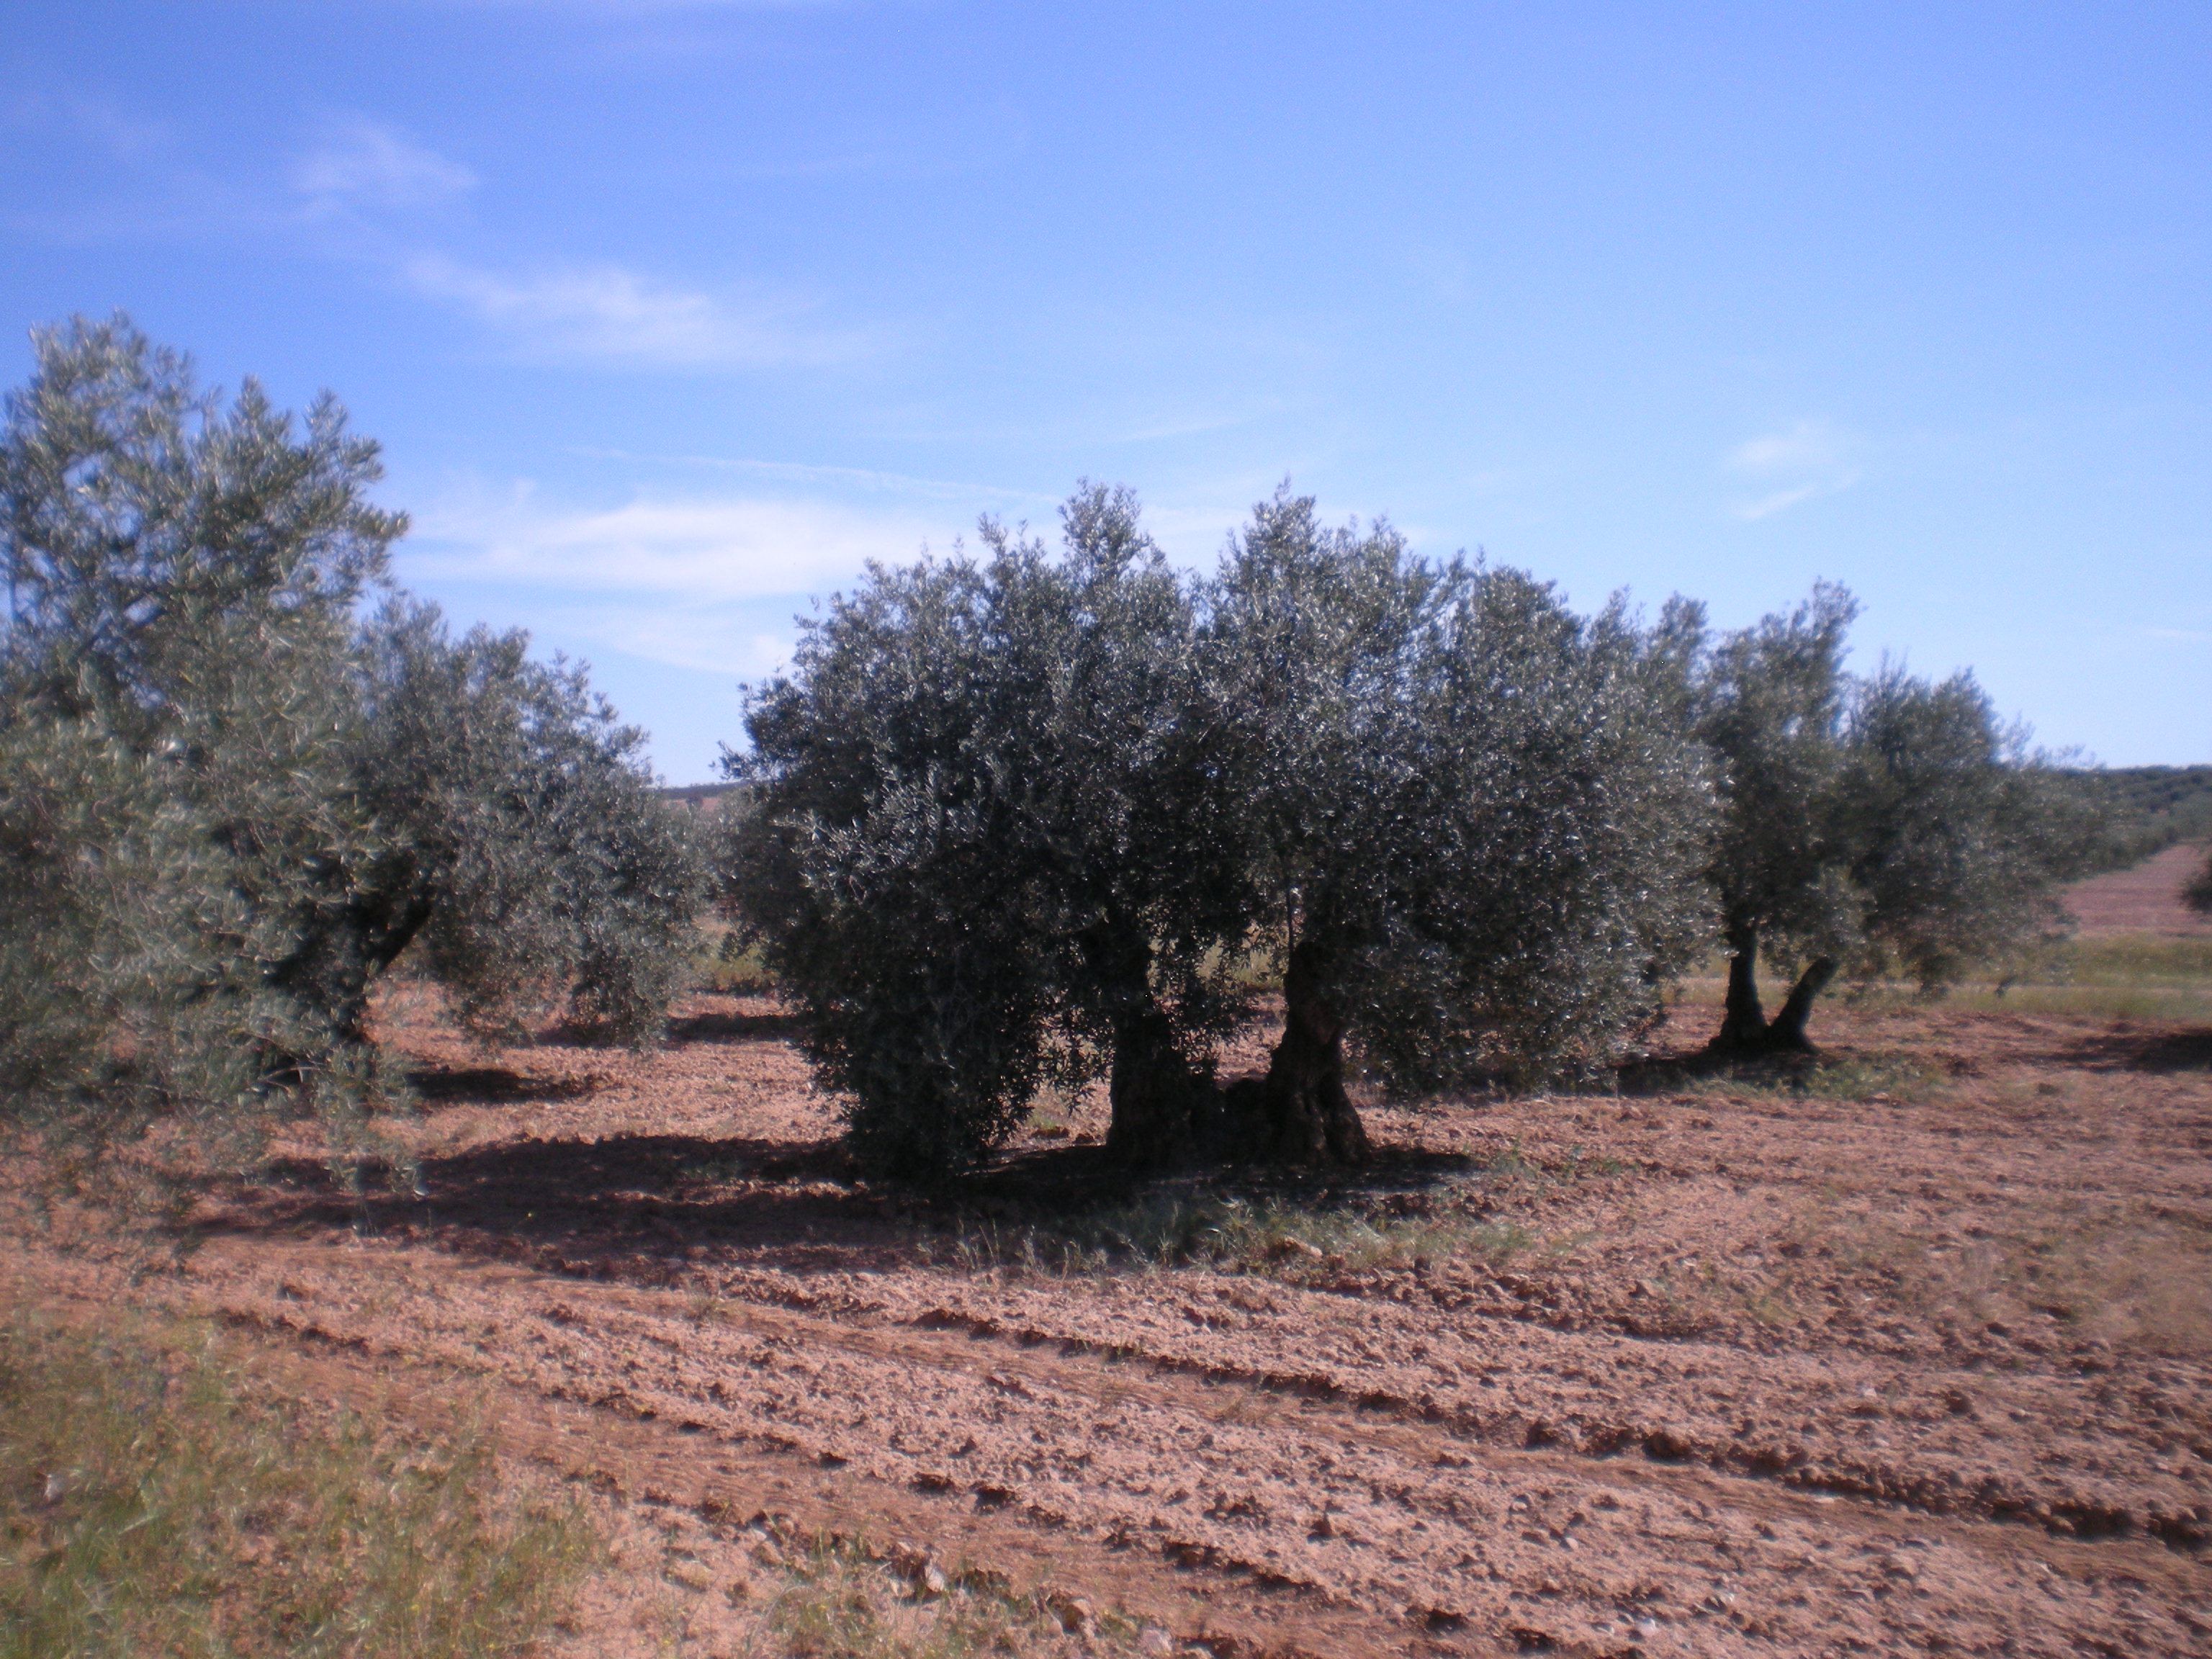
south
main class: Cropland
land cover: Olive groves
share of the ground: 10 - 25 %
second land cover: Spontaneously vegetated surfaces
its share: 10 - 25 %
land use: Agriculture (excluding fallow land and kitchen gardens)
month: May
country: ES
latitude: 38.5009
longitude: -3.5278
